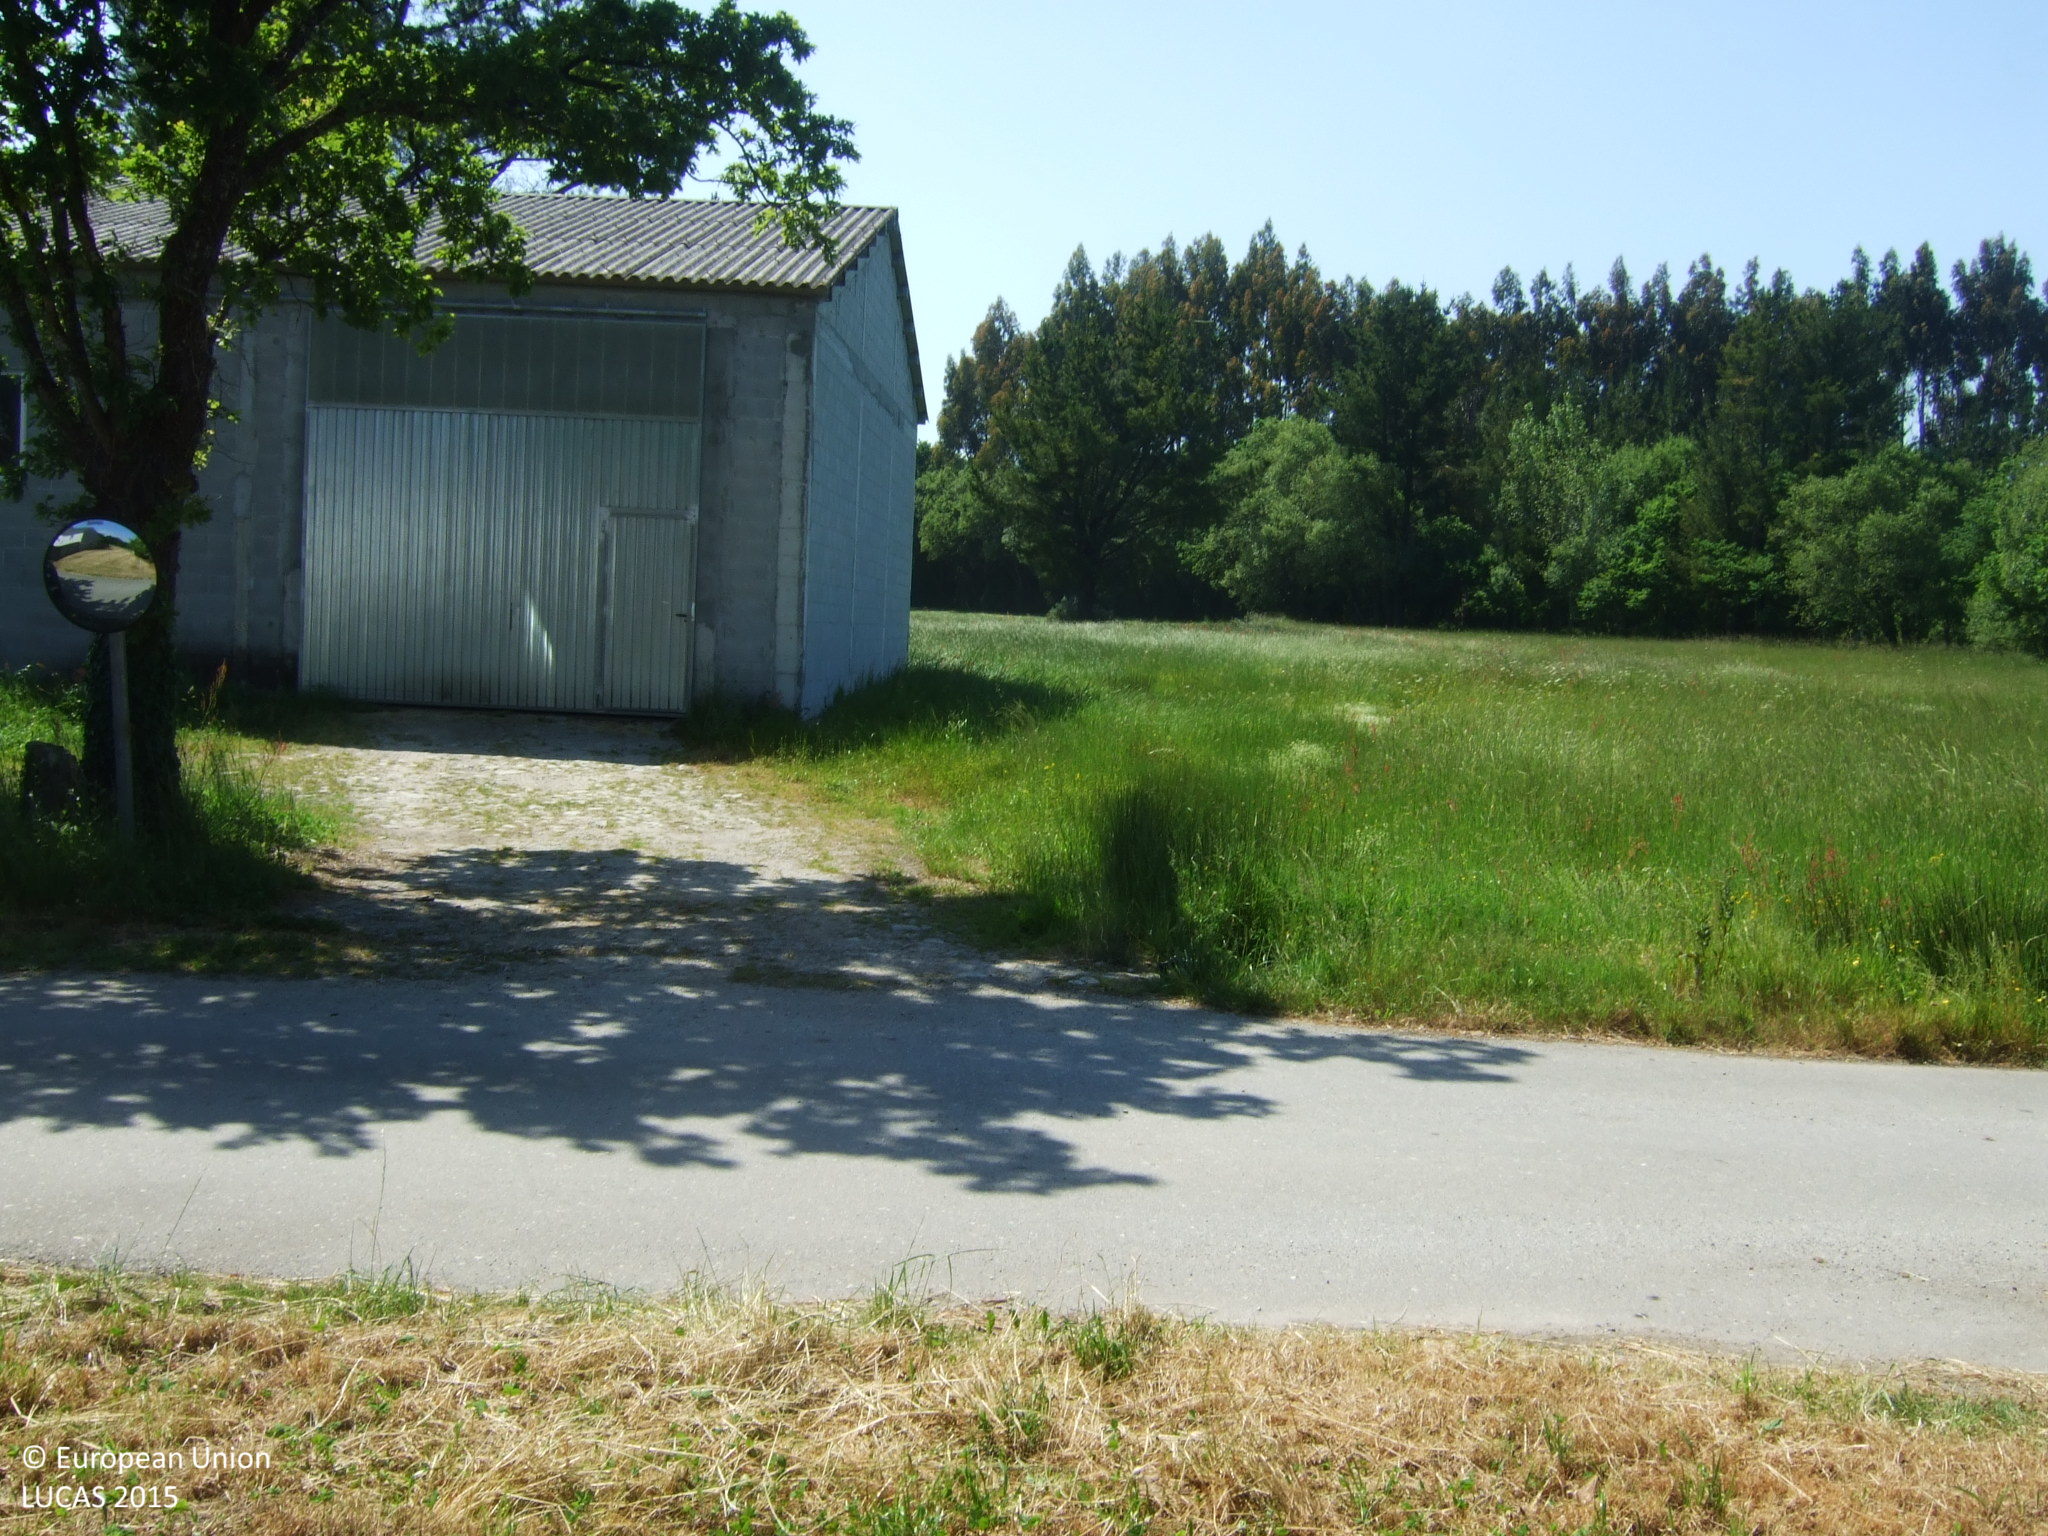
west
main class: Grassland
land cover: Grassland without tree/shrub cover
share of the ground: > 75 %
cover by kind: herbaceous plants 100 %
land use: Agriculture (excluding fallow land and kitchen gardens)
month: June
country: ES
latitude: 43.2790
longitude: -7.4652
